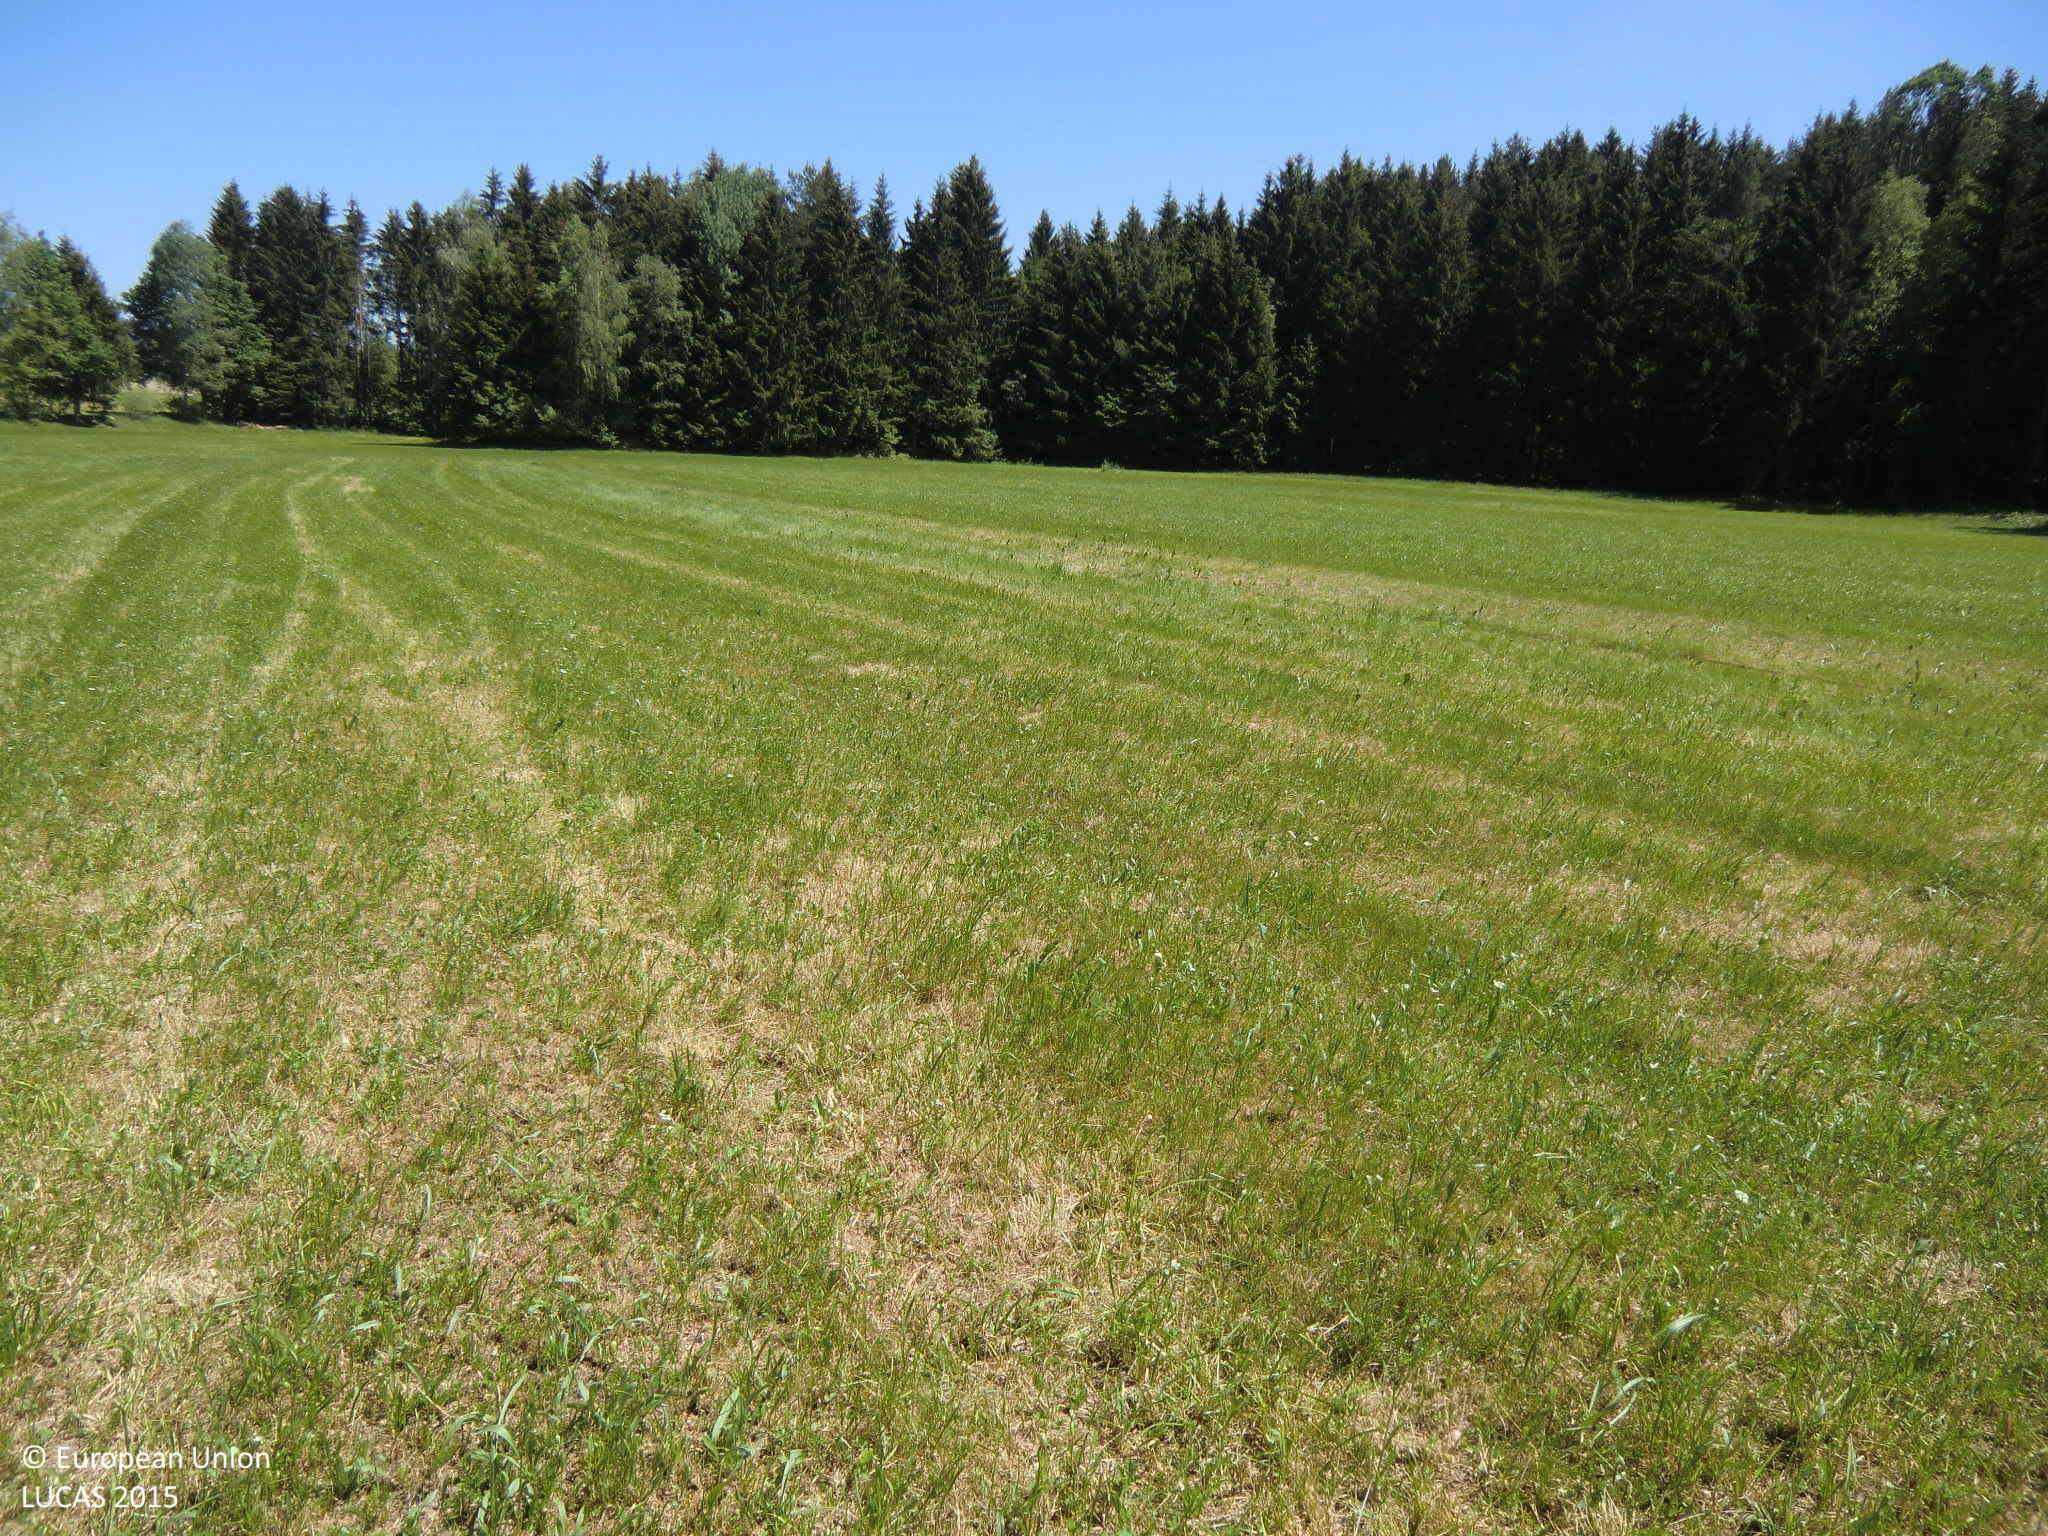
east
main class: Grassland
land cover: Grassland without tree/shrub cover
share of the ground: > 75 %
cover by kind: herbaceous plants 100 %
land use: Agriculture (excluding fallow land and kitchen gardens)
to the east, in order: Grassland without tree/shrub cover; Tracks; Spruce dominated coniferous woodland; Tracks; Grassland without tree/shrub cover
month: June
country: AT
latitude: 48.6377
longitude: 14.4655
